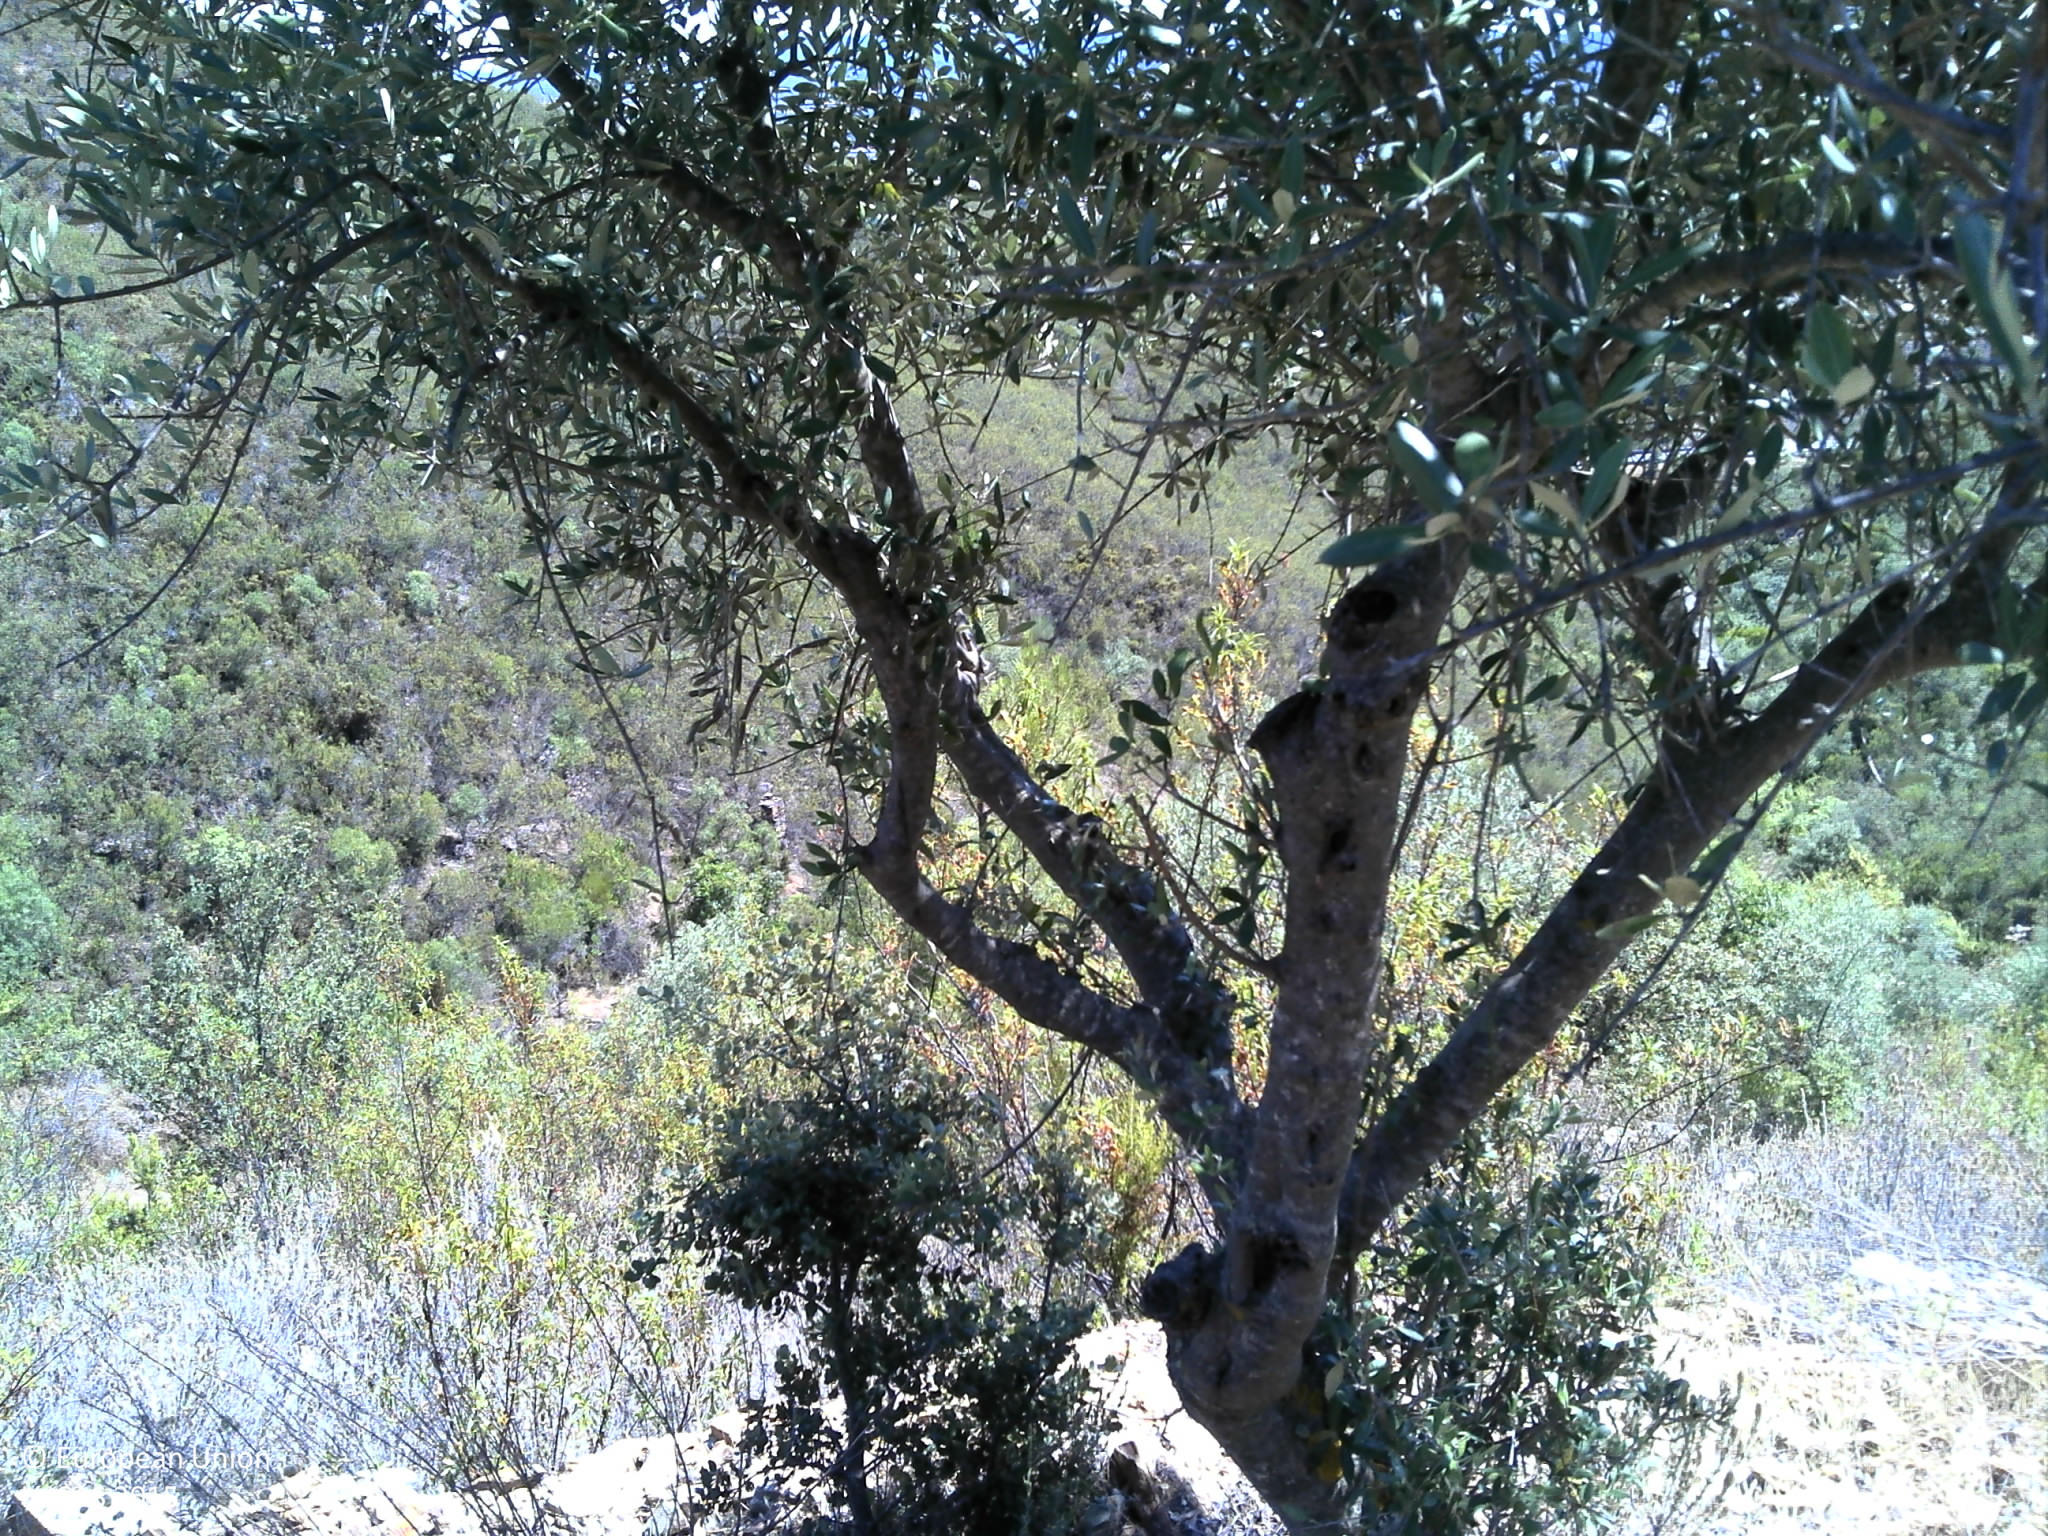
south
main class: Cropland
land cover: Olive groves
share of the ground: < 10 %
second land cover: Shrubland without tree cover
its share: 50 - 75 %
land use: Abandoned areas
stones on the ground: 10 - 25 %
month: July
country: PT
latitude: 39.6829
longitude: -7.6718
